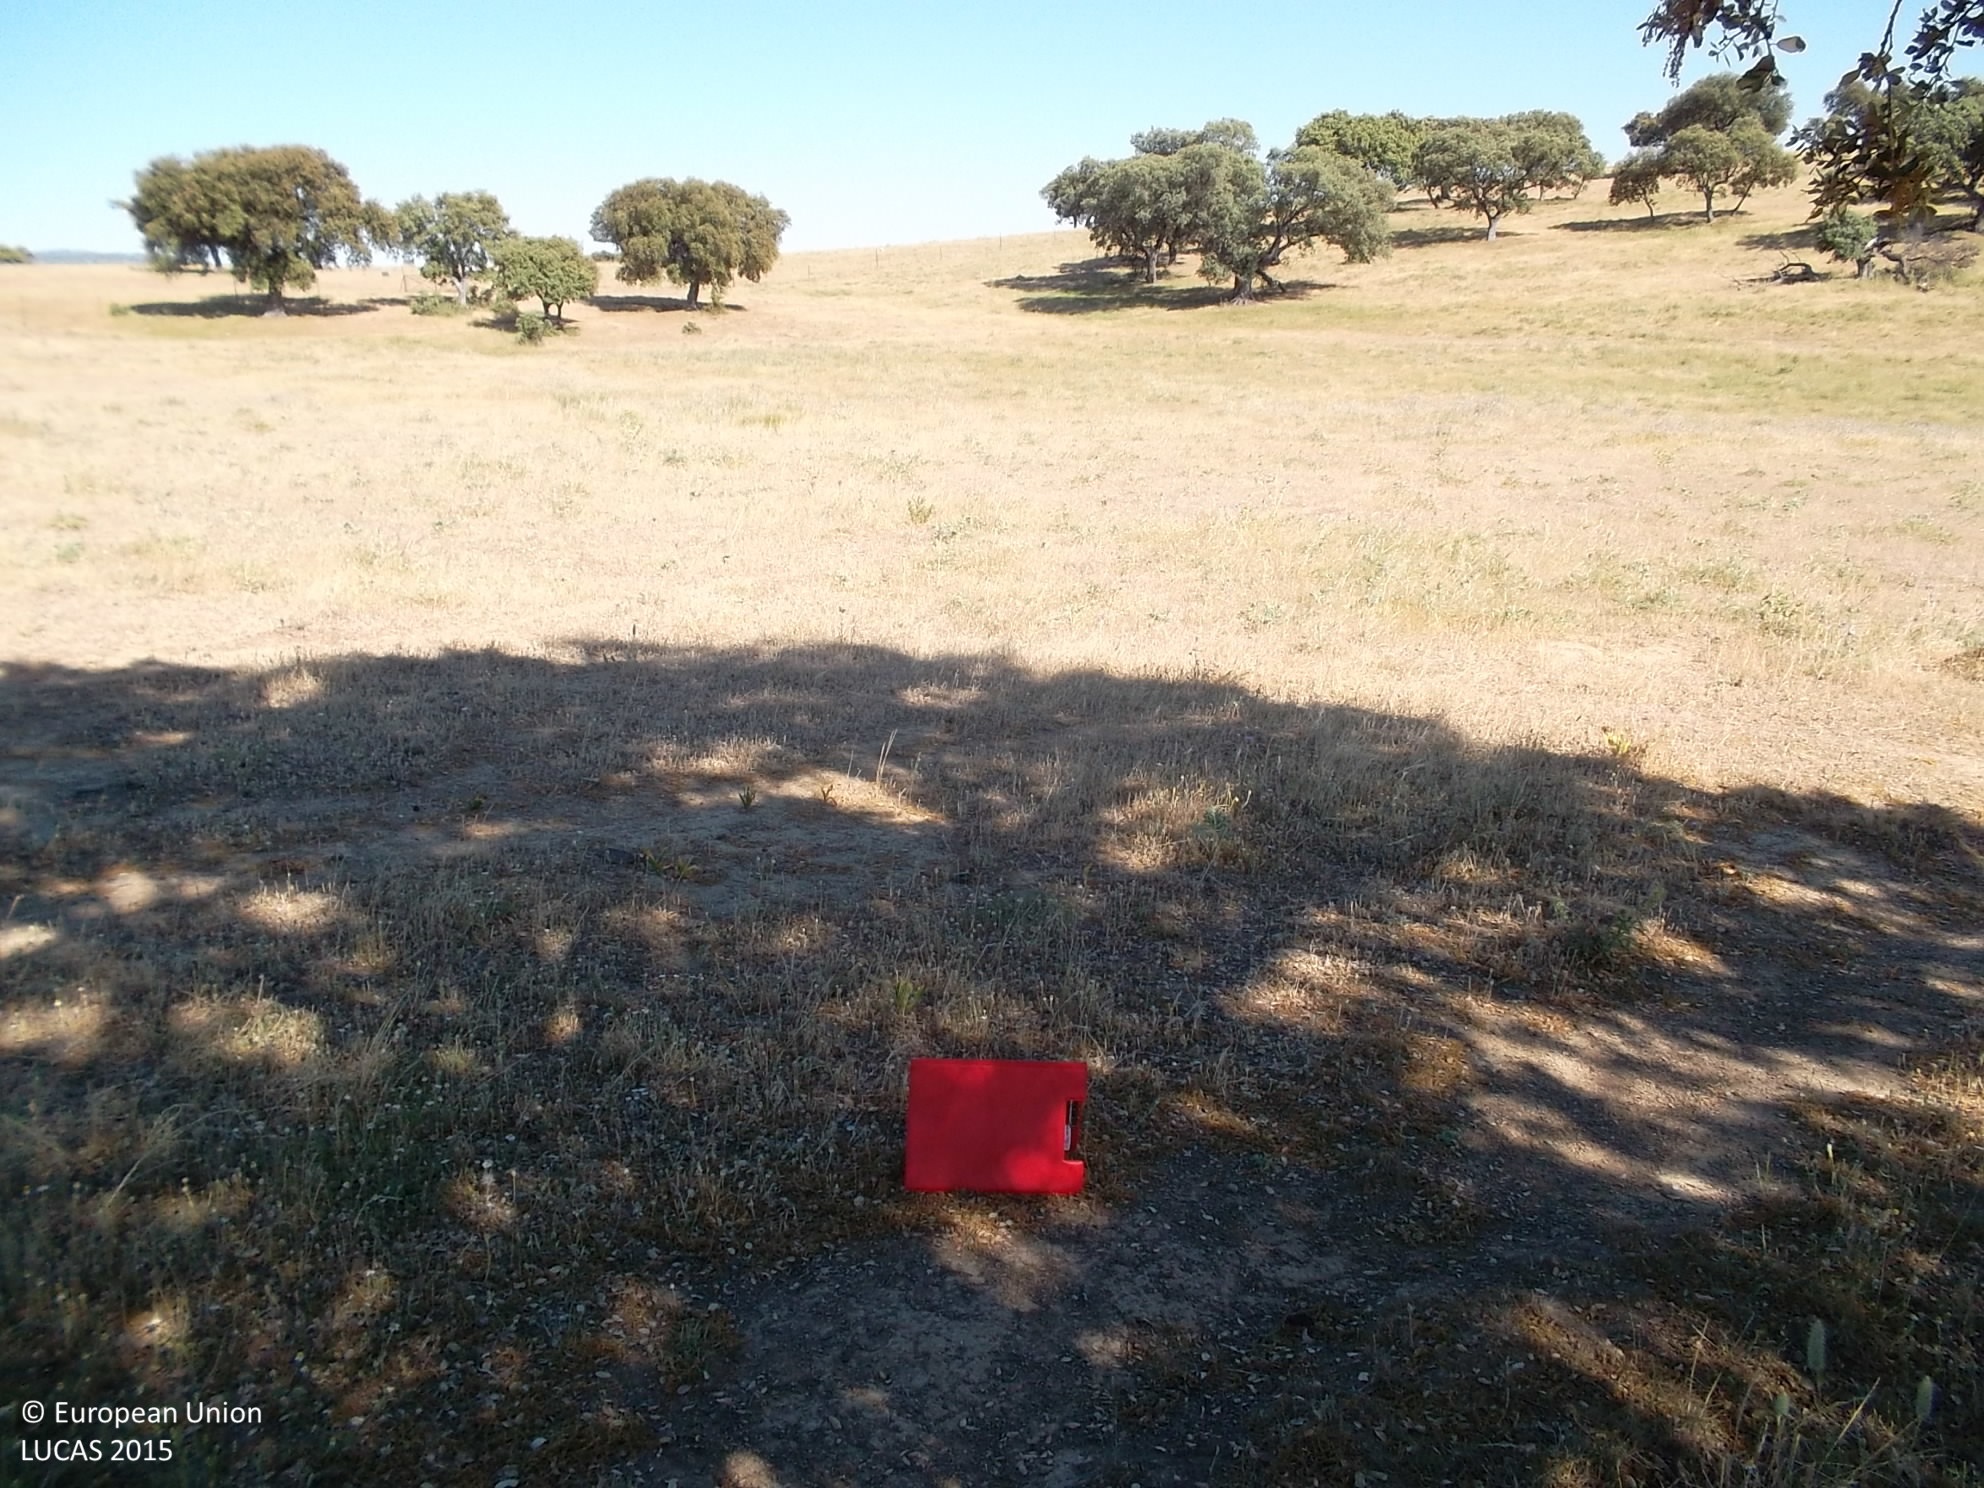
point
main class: Grassland
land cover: Grassland with sparse tree/shrub cover
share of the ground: 50 - 75 %
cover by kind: herbaceous plants 85 %, shrubs 10 %, broadleaved forest trees 5 %
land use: Agriculture (excluding fallow land and kitchen gardens)
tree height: > 5 m
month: May
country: ES
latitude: 38.6455
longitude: -4.4181
